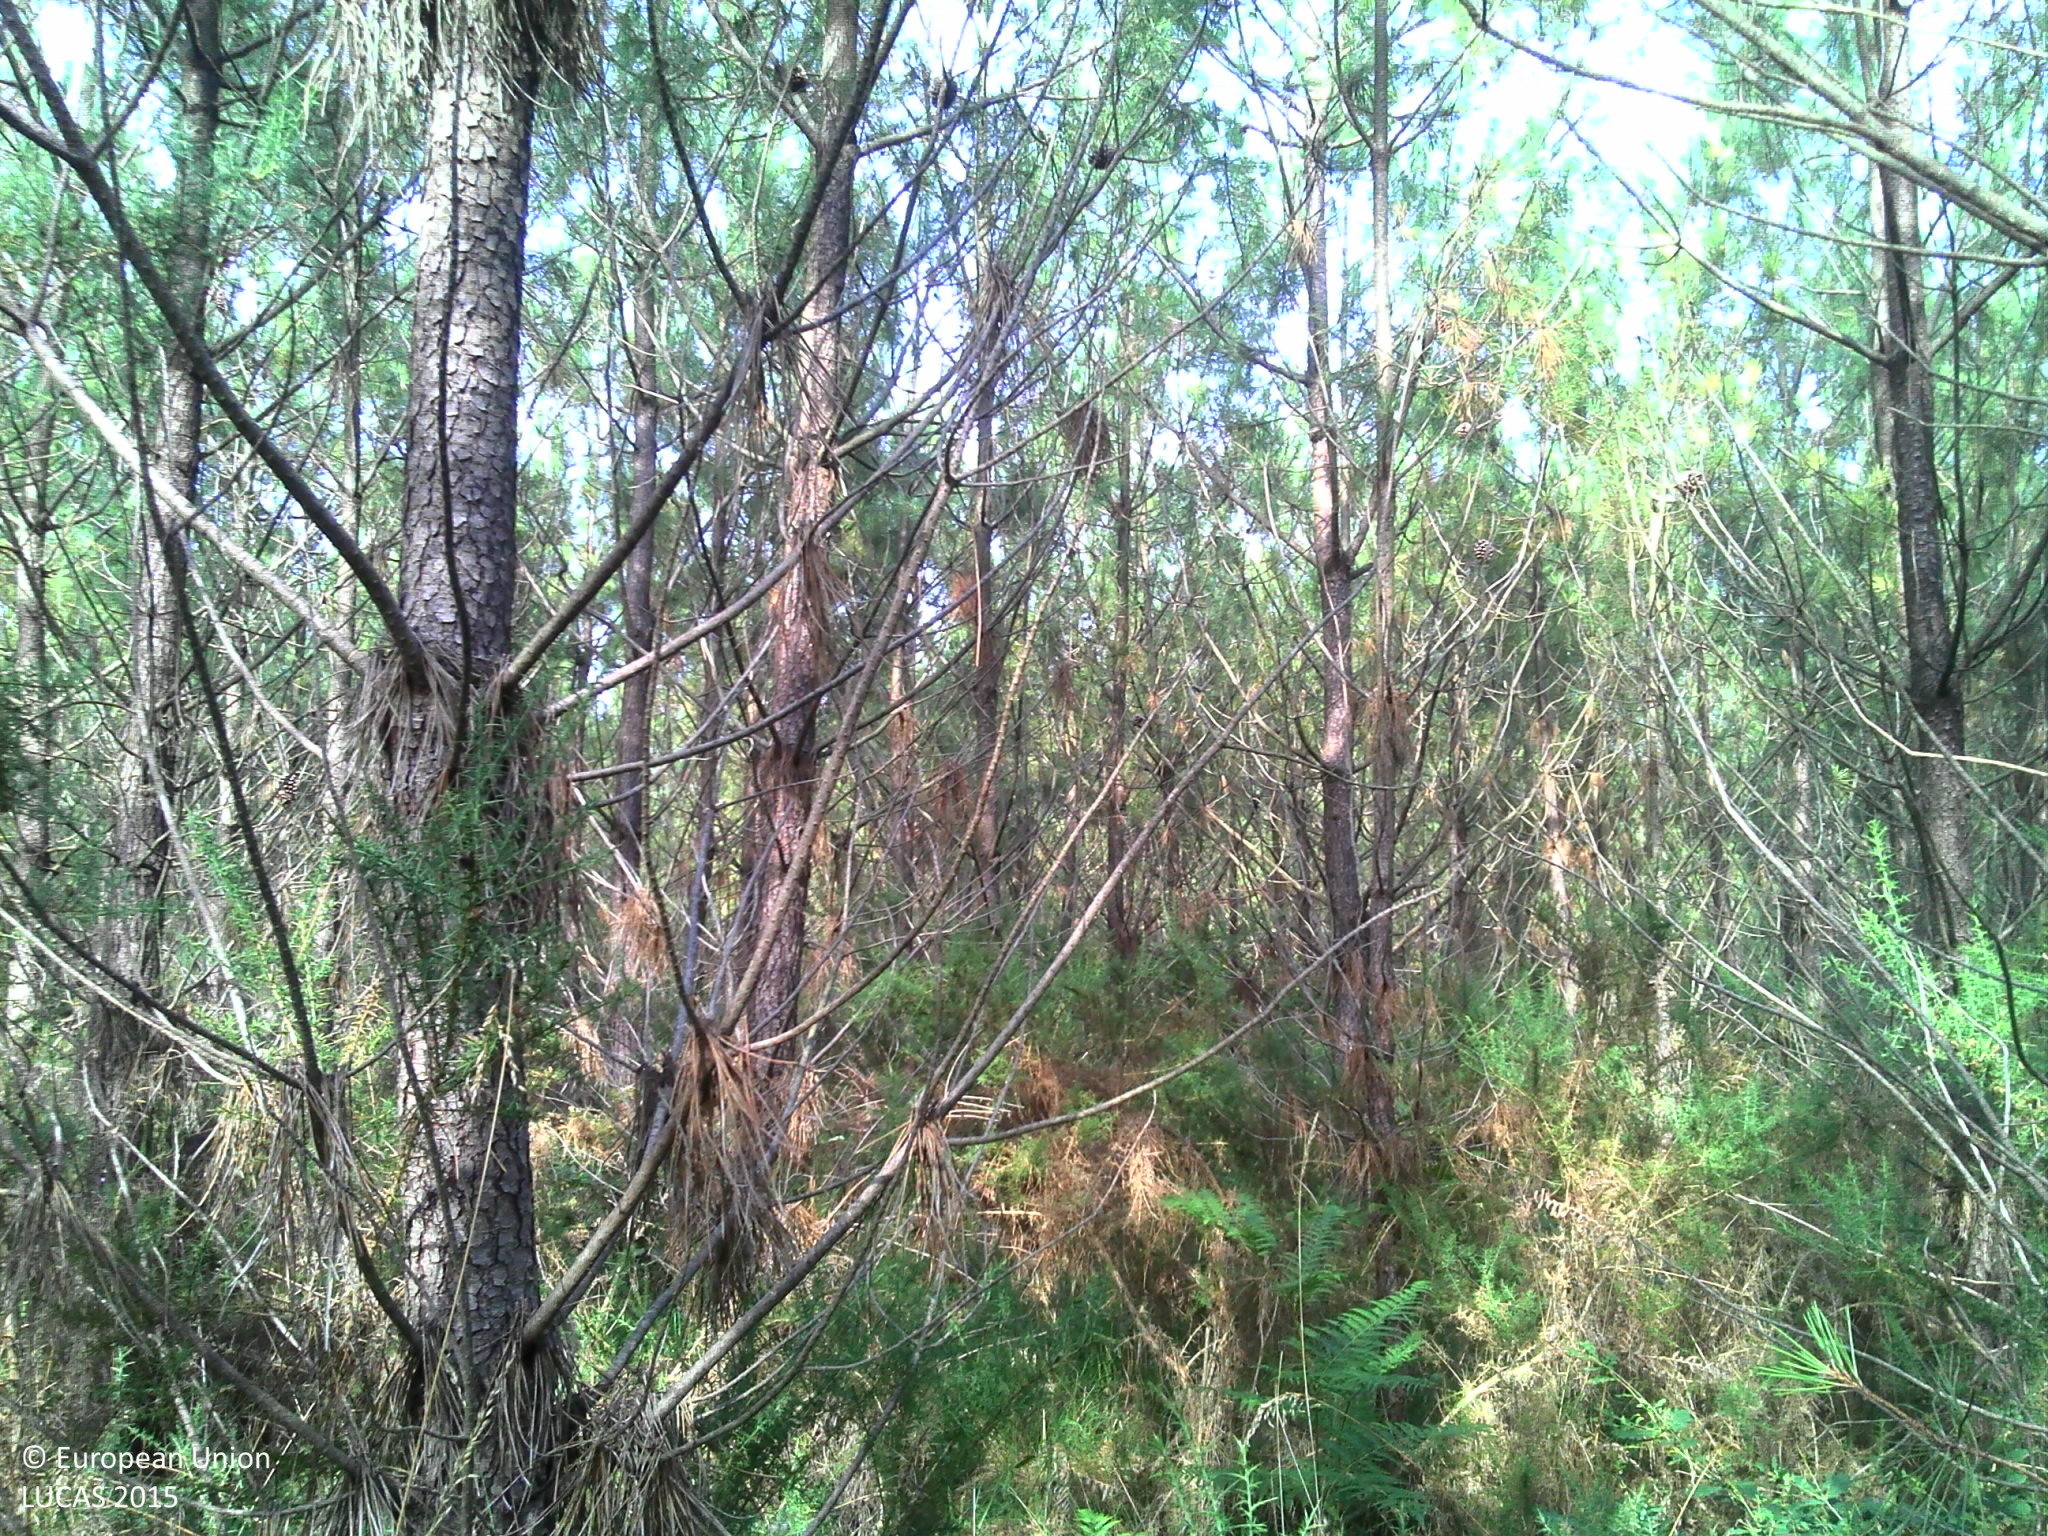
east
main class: Woodland
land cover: Pine dominated coniferous woodland
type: coniferous forest of the mediterranean region
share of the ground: > 75 %
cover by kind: coniferous forest trees 80 %, herbaceous plants 10 %, broadleaved forest trees 5 %, shrubs 5 %
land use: Forestry
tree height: > 5 m
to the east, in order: Pine dominated coniferous woodland; Grass margins; Tracks; Grass margins; Pine dominated coniferous woodland; Shrubland with sparse tree cover; Tracks; Maize
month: July
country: FR
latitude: 43.7363
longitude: -1.2543
